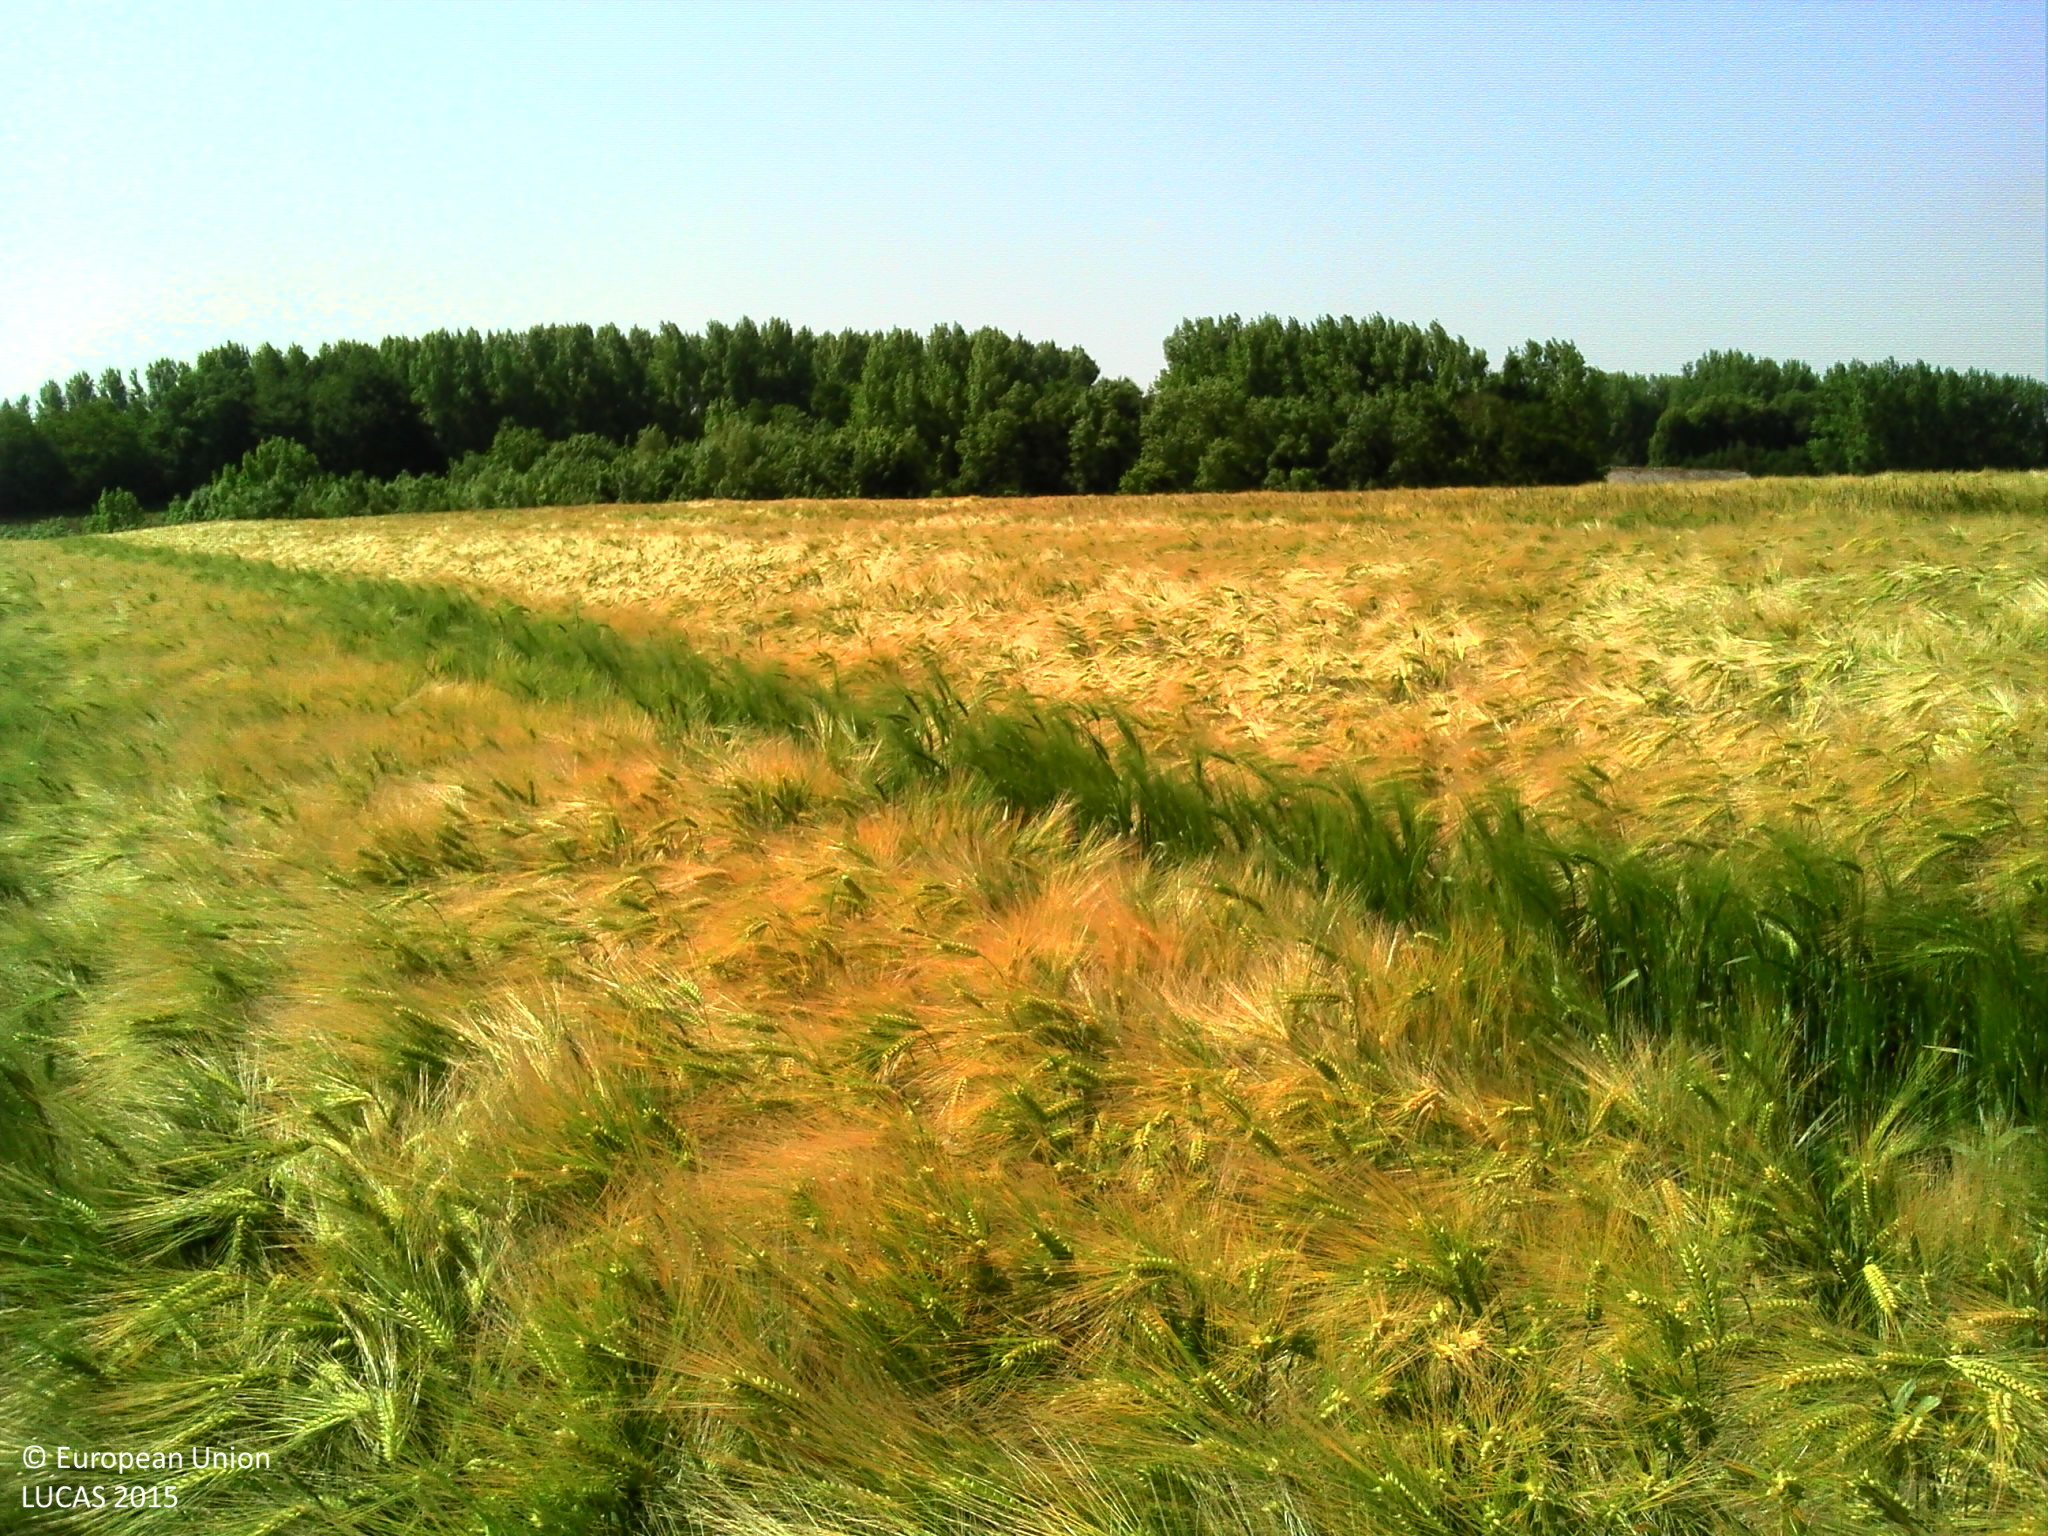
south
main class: Cropland
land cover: Barley
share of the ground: > 75 %
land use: Agriculture (excluding fallow land and kitchen gardens)
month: June
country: FR
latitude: 50.4416
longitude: 2.4821
